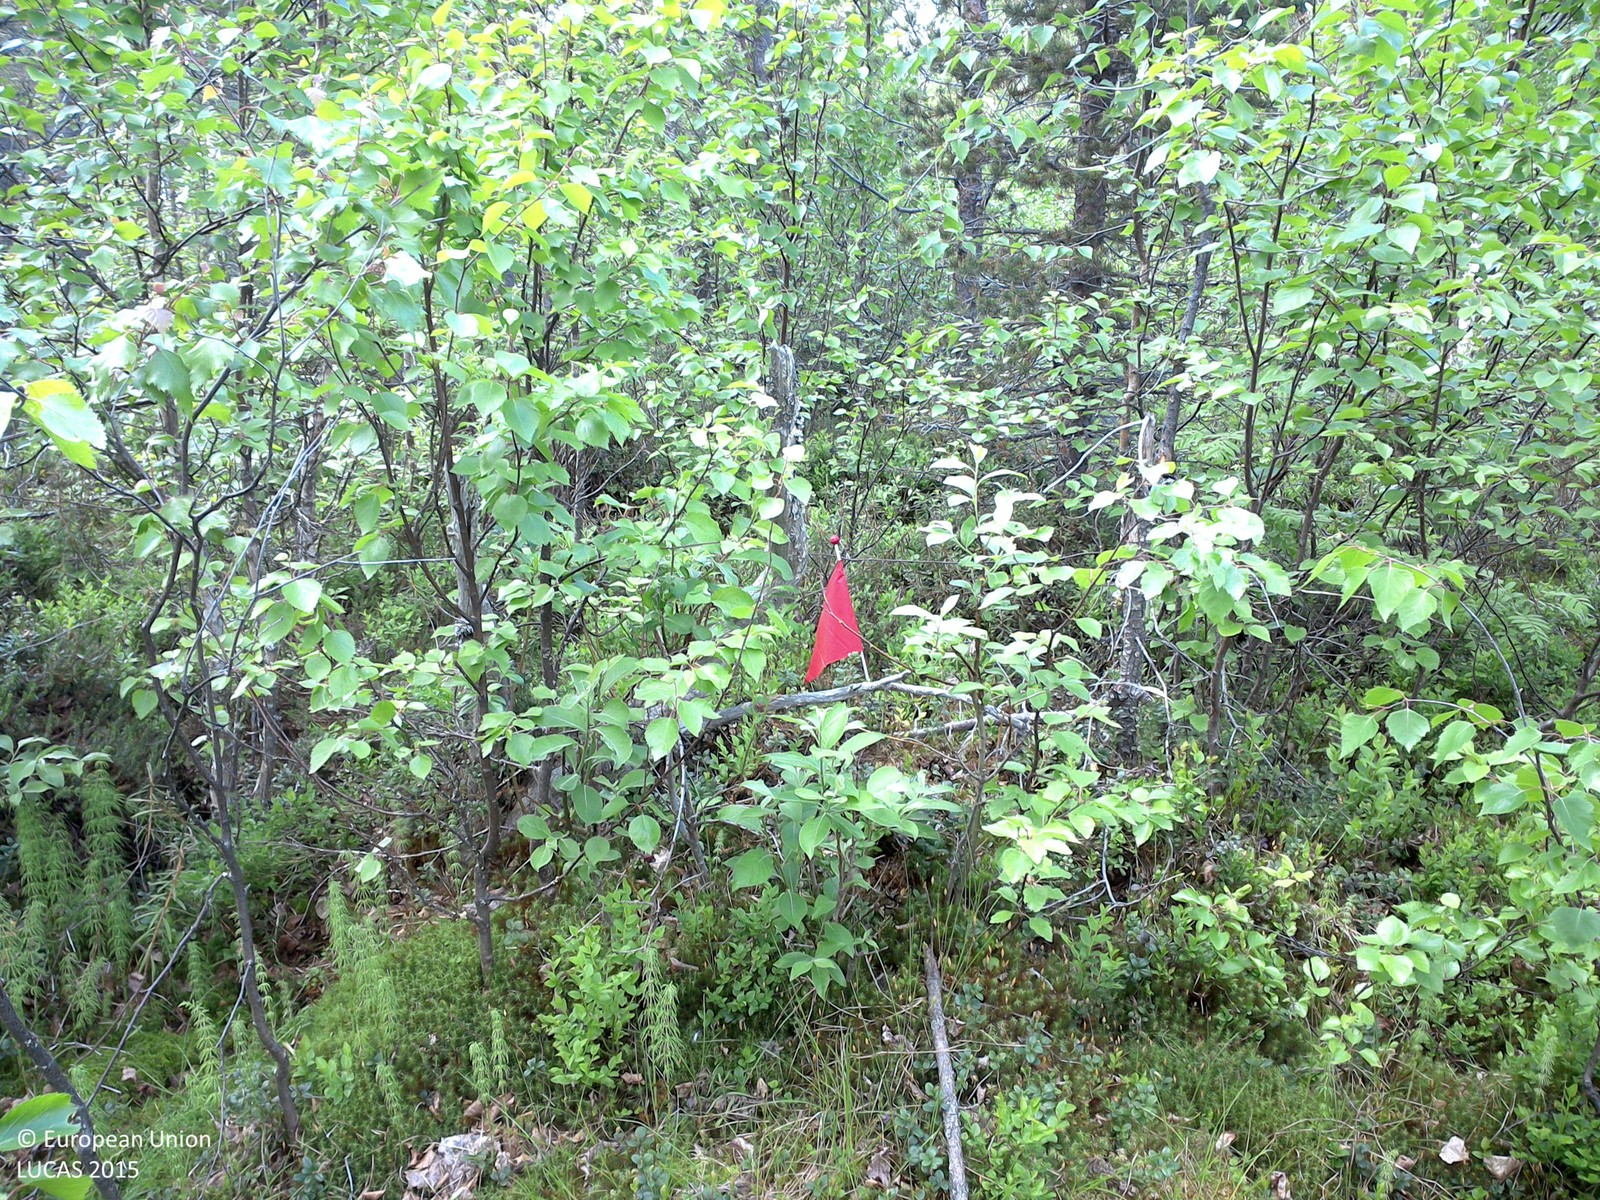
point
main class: Woodland
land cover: Pine dominated mixed woodland
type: boreal forest
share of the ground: 25 - 50 %
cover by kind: shrubs 45 %, coniferous forest trees 30 %, broadleaved forest trees 15 %, herbaceous plants 5 %
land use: Forestry
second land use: Amenities, museums, leisure
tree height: > 5 m
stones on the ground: < 10 %
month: June
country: SE
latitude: 66.6418
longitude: 22.9259
